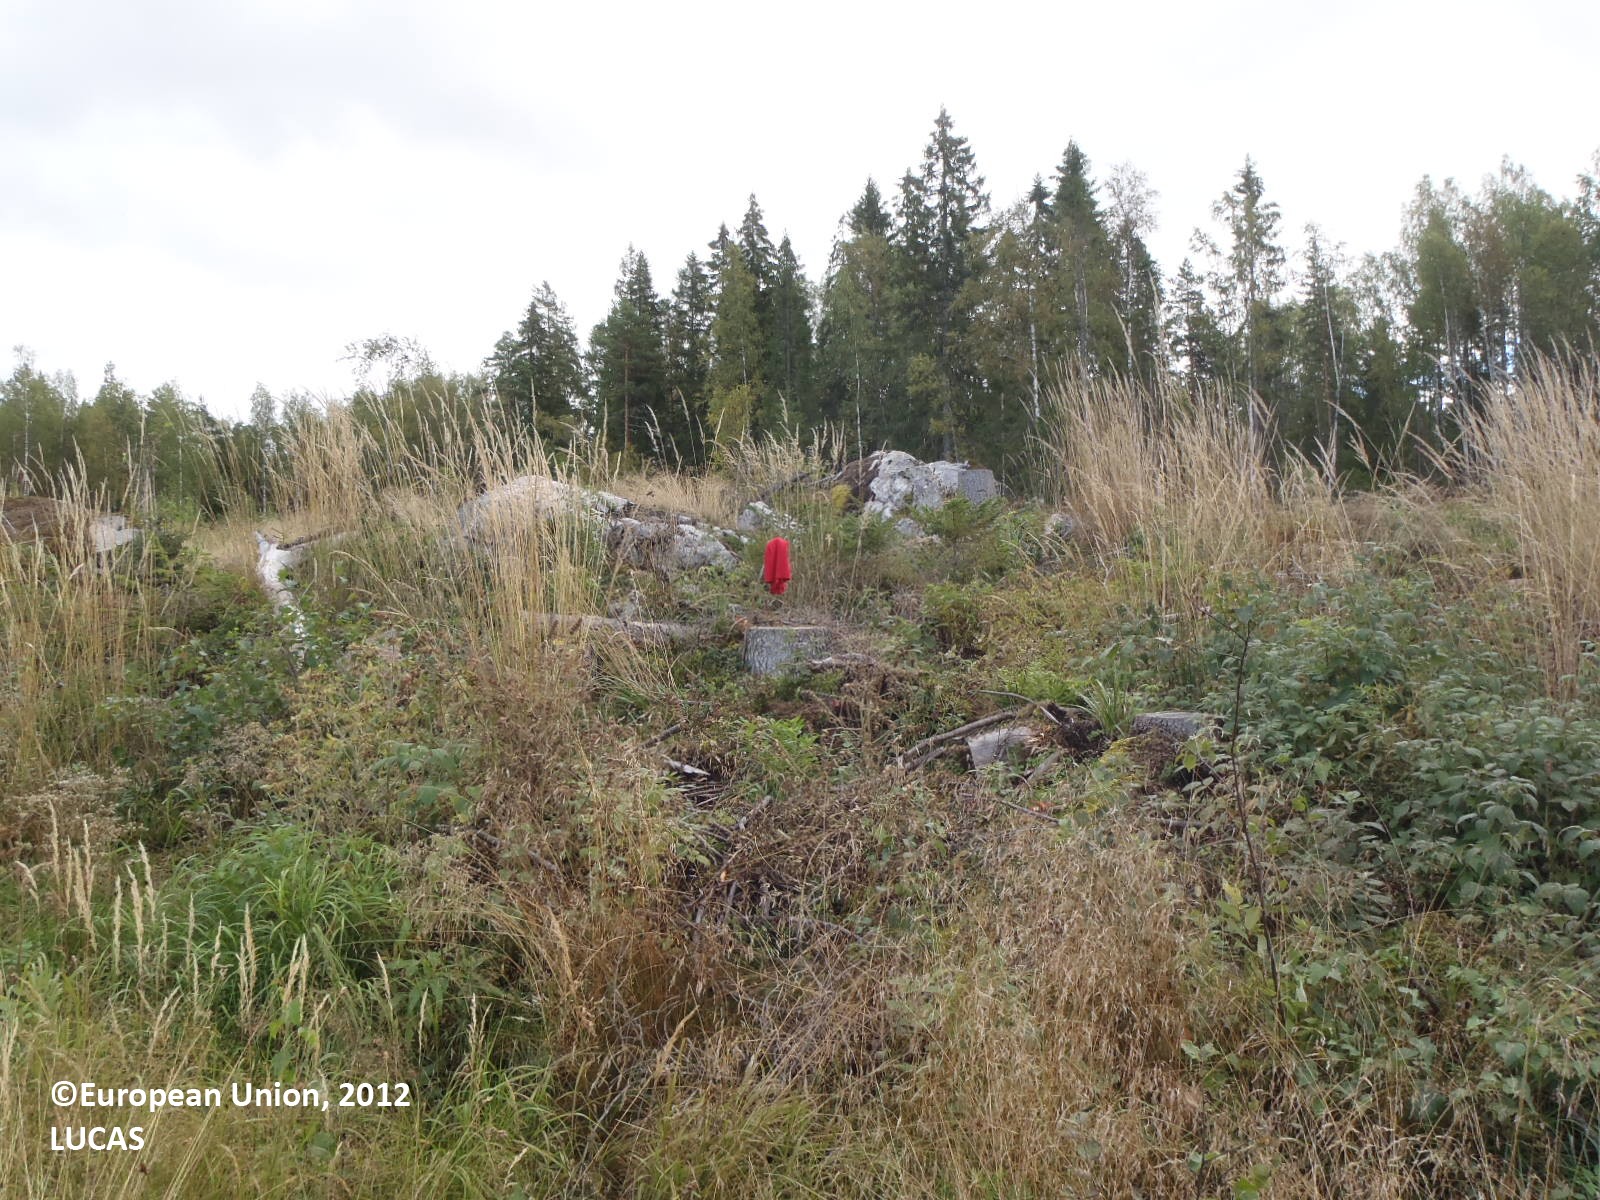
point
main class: Shrubland
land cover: Shrubland with sparse tree cover
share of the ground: > 75 %
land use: Forestry
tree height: > 5 m
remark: Clear cut
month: September
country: FI
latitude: 61.2917
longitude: 22.6264
